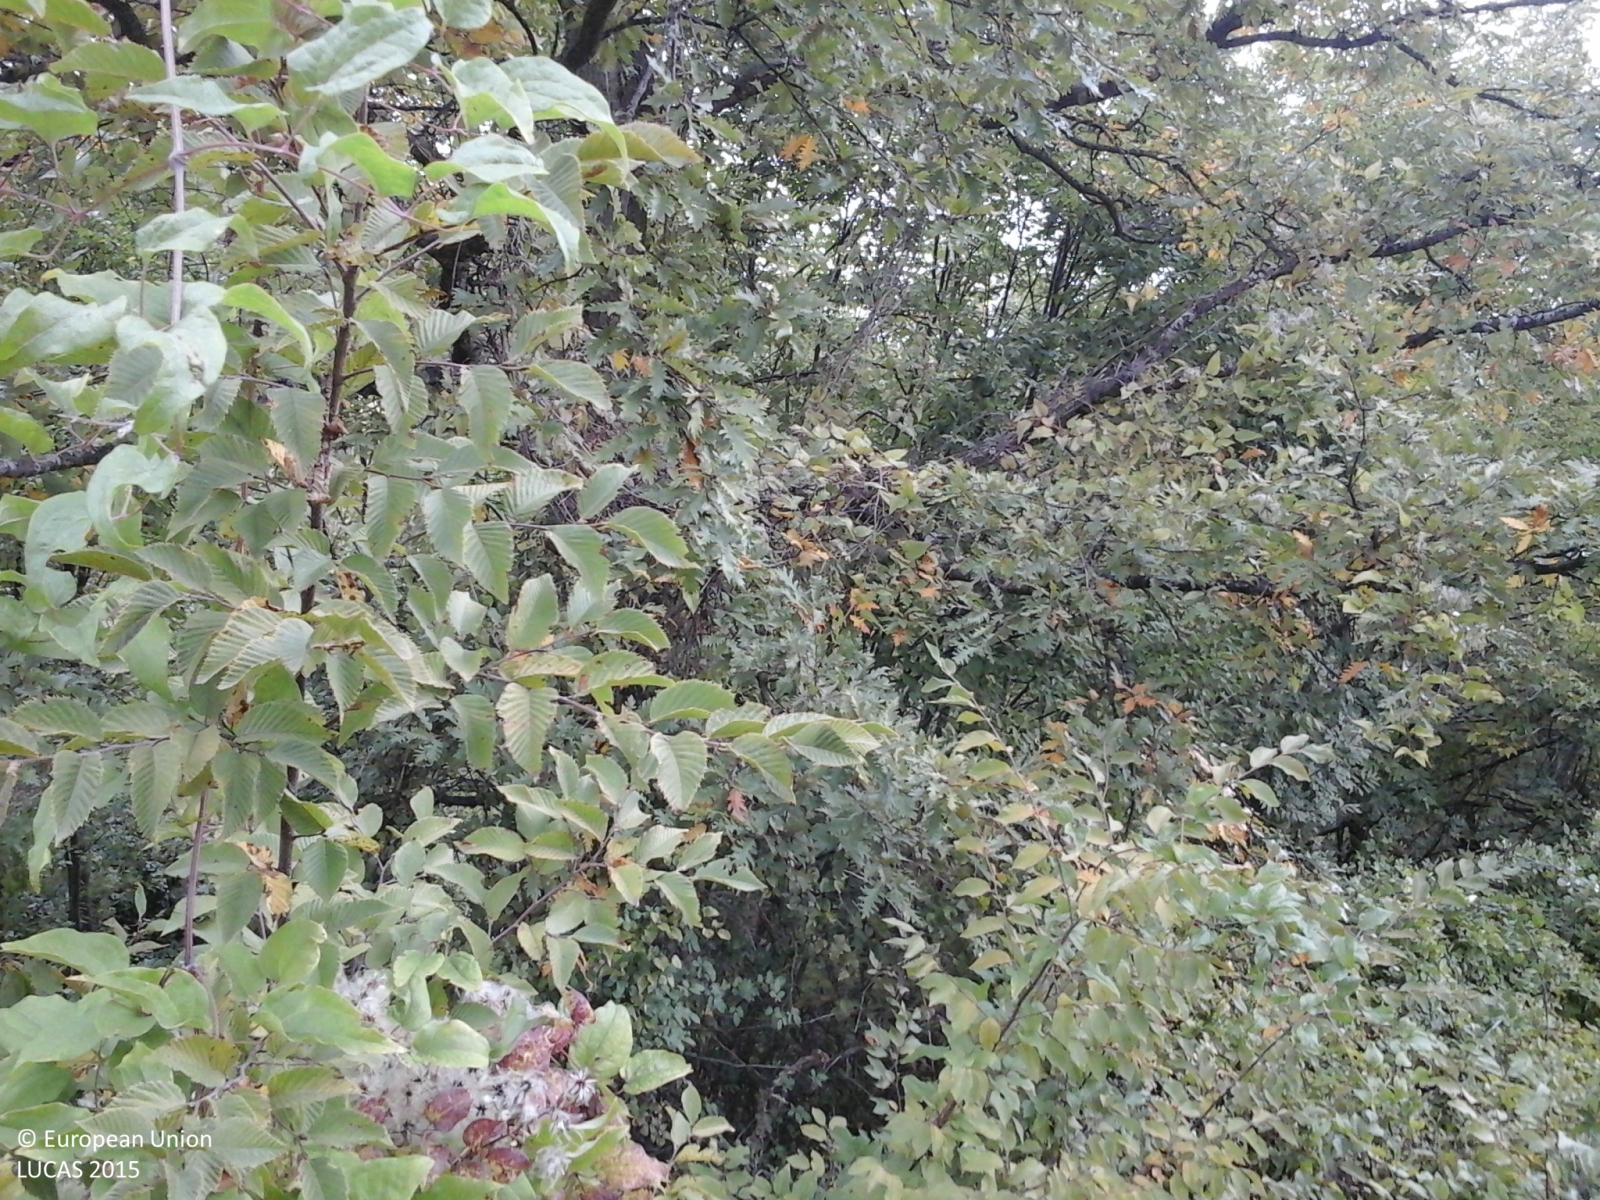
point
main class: Woodland
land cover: Broadleaved woodland
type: thermophilous deciduous forest
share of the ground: > 75 %
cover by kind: broadleaved forest trees 90 %, shrubs 10 %
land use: Forestry
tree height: > 5 m
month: October
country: IT
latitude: 43.1996
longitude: 12.5649
